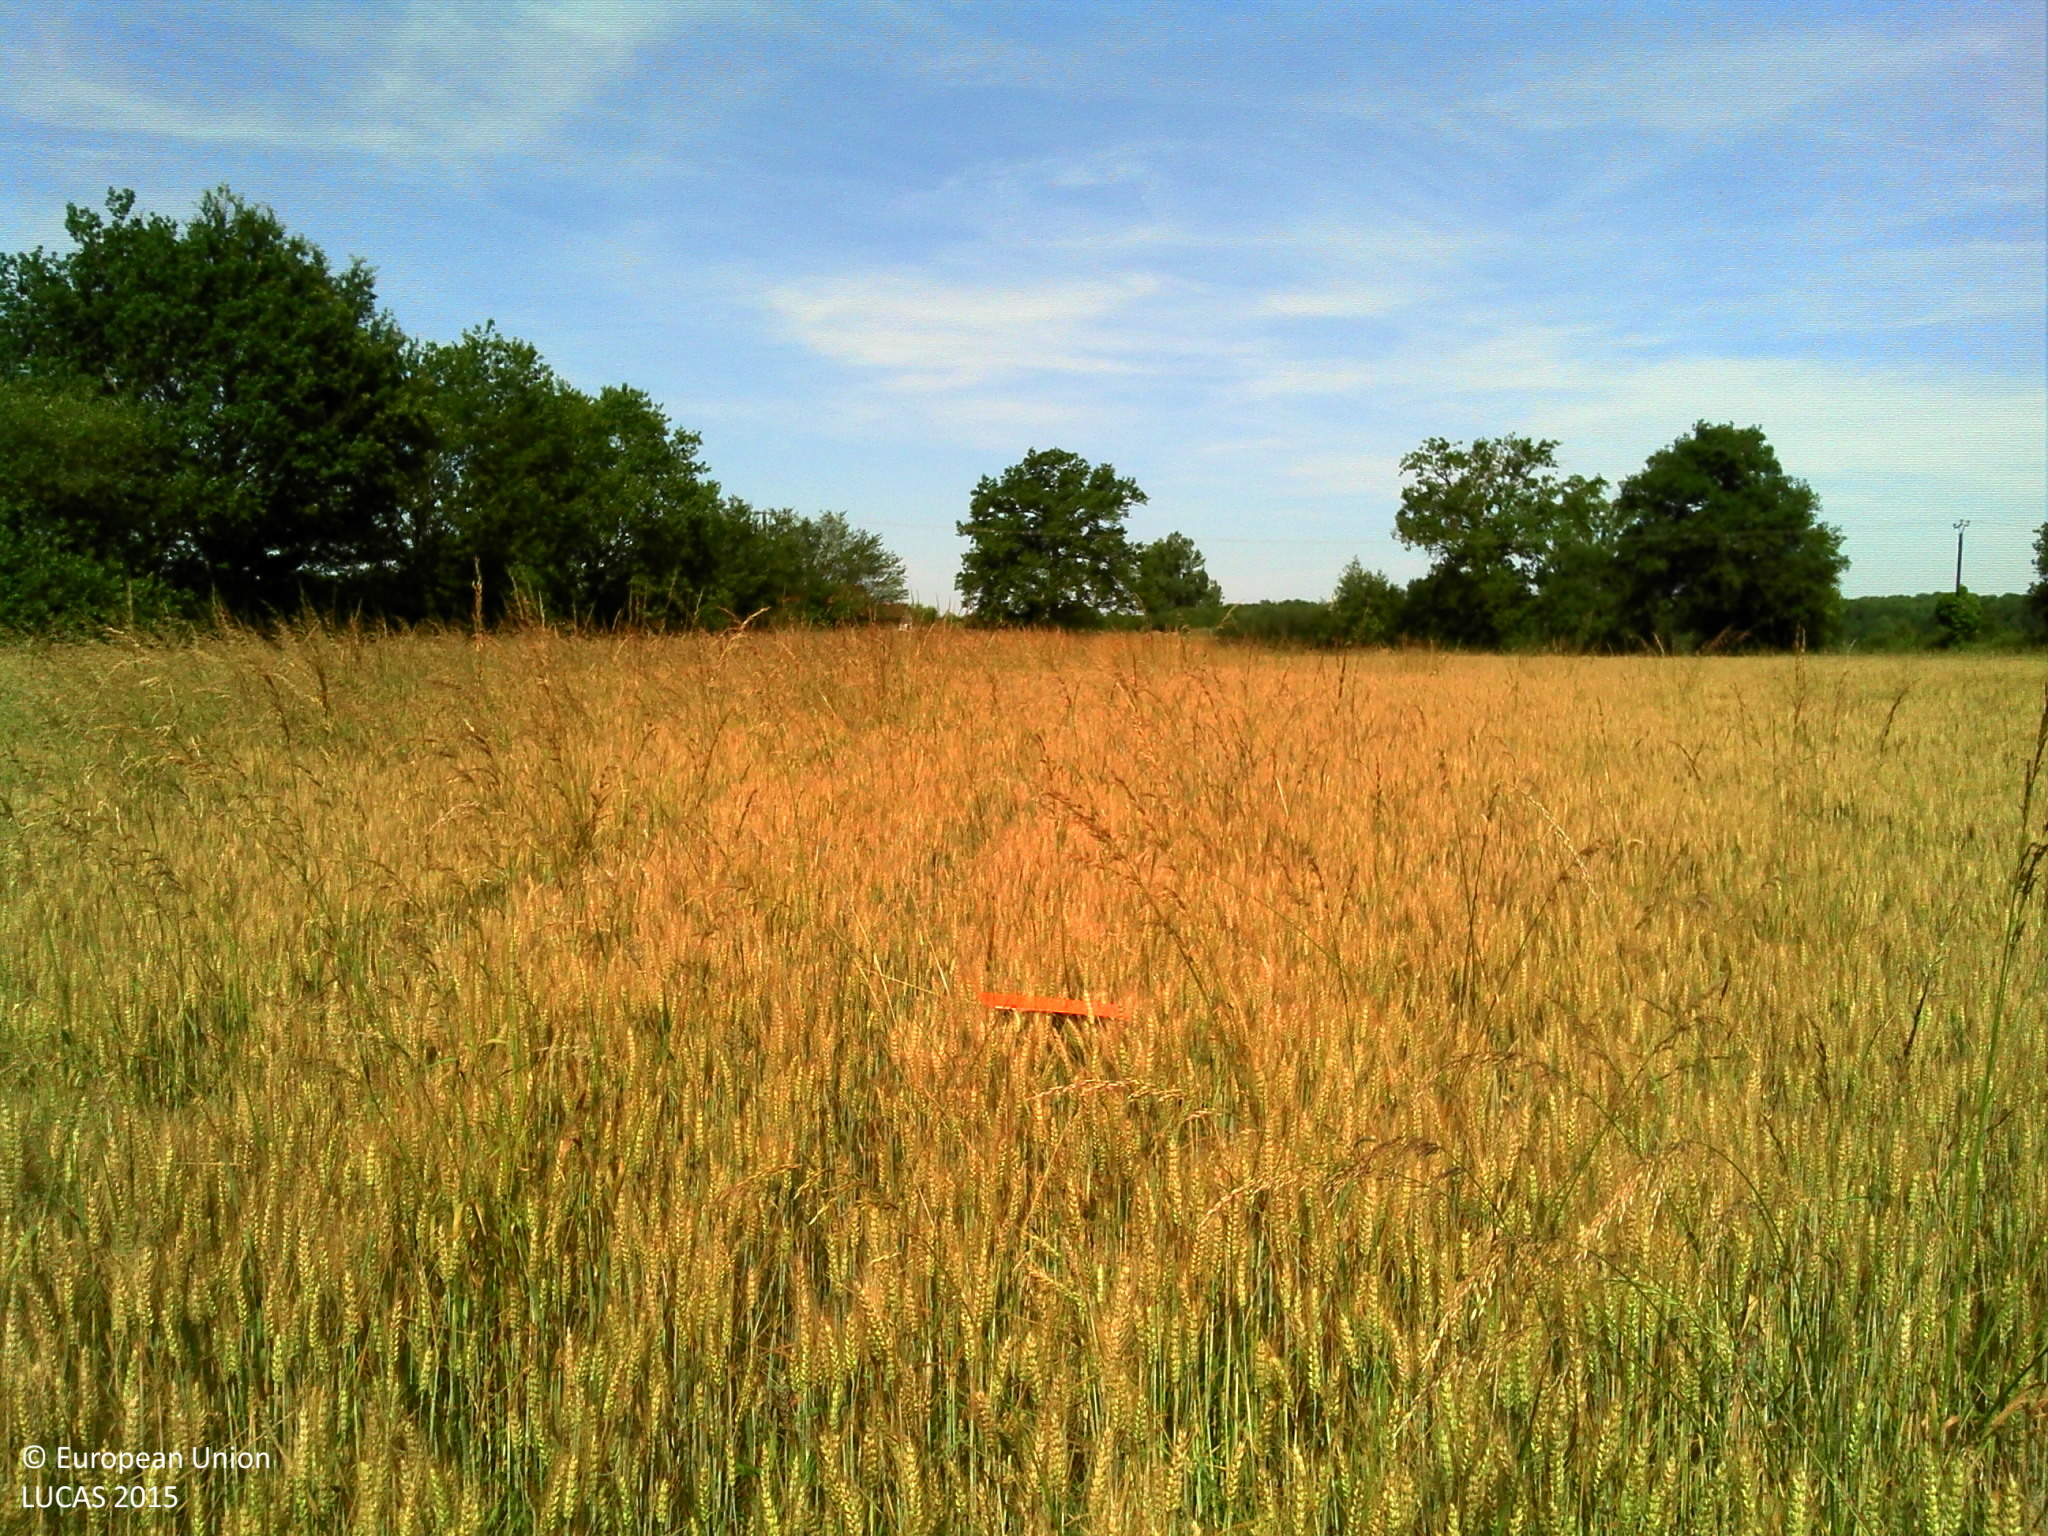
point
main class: Cropland
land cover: Common wheat
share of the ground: > 75 %
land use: Agriculture (excluding fallow land and kitchen gardens)
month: June
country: FR
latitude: 44.4954
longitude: 2.0149
